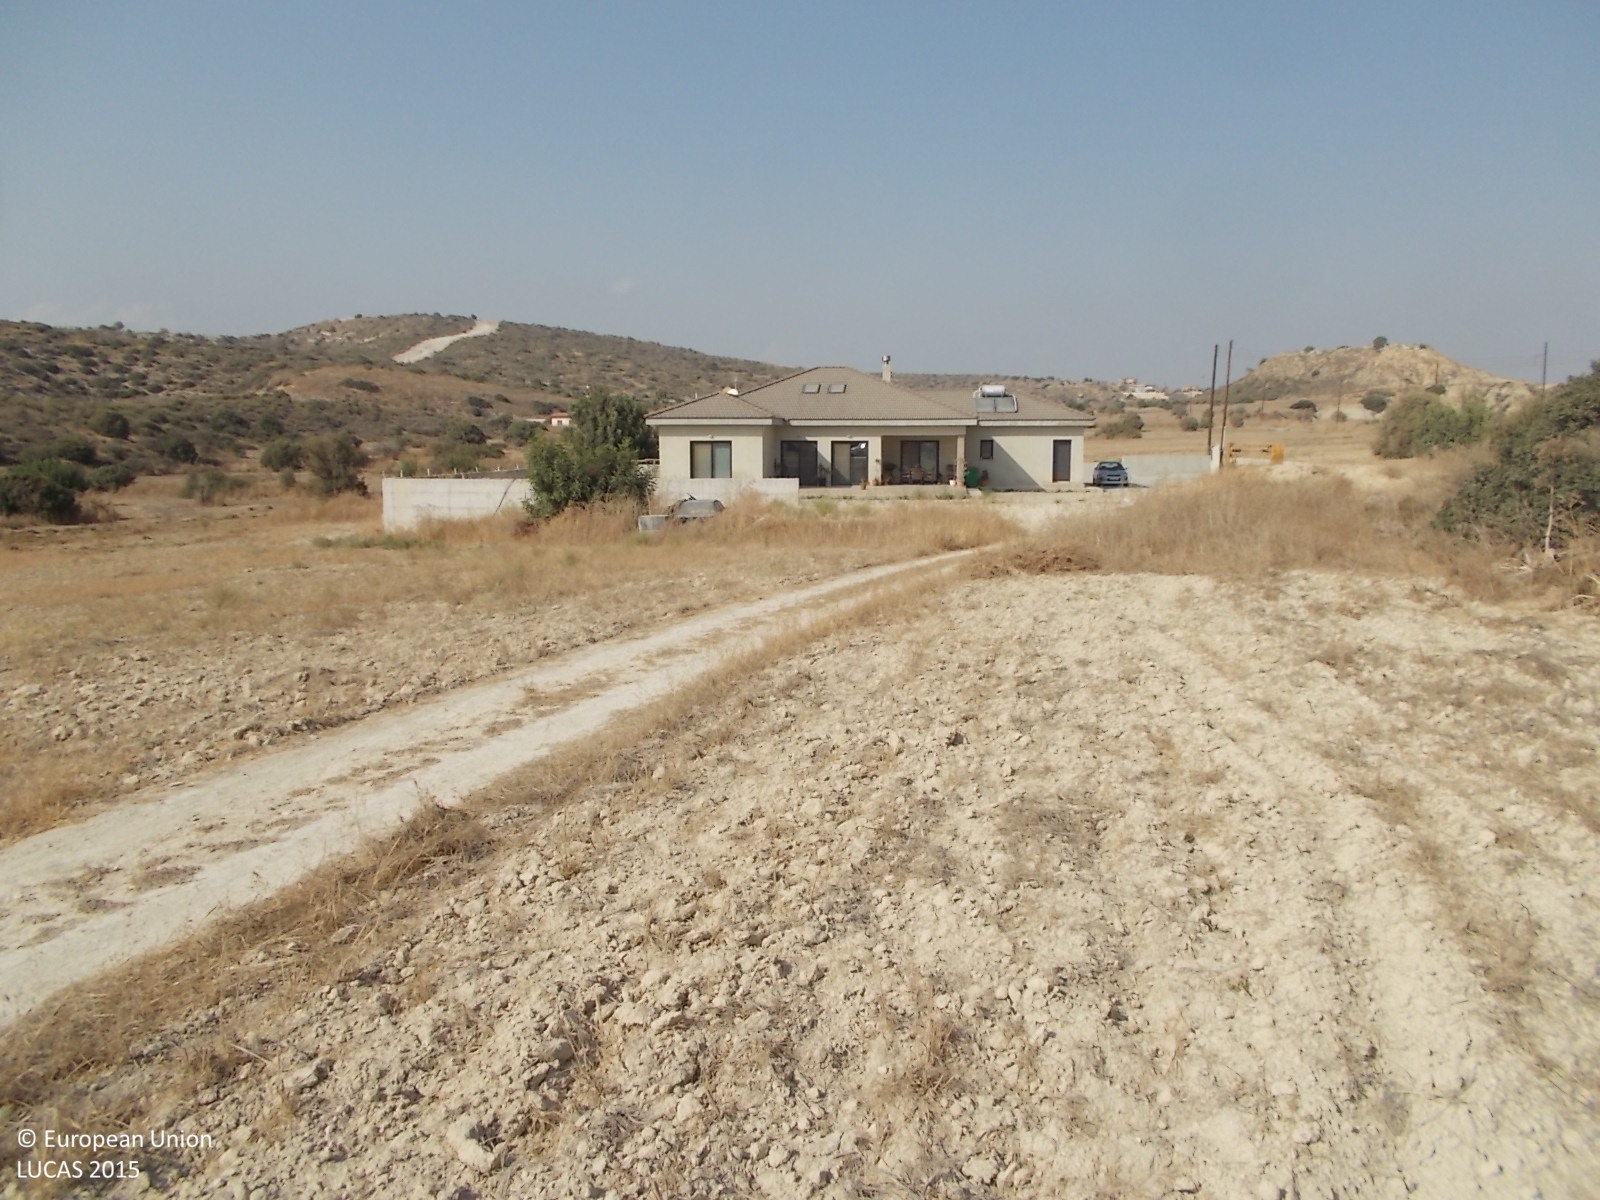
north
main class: Cropland
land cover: Oats
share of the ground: < 10 %
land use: Agriculture (excluding fallow land and kitchen gardens)
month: April
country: CY
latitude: 34.7706
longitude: 33.3094
